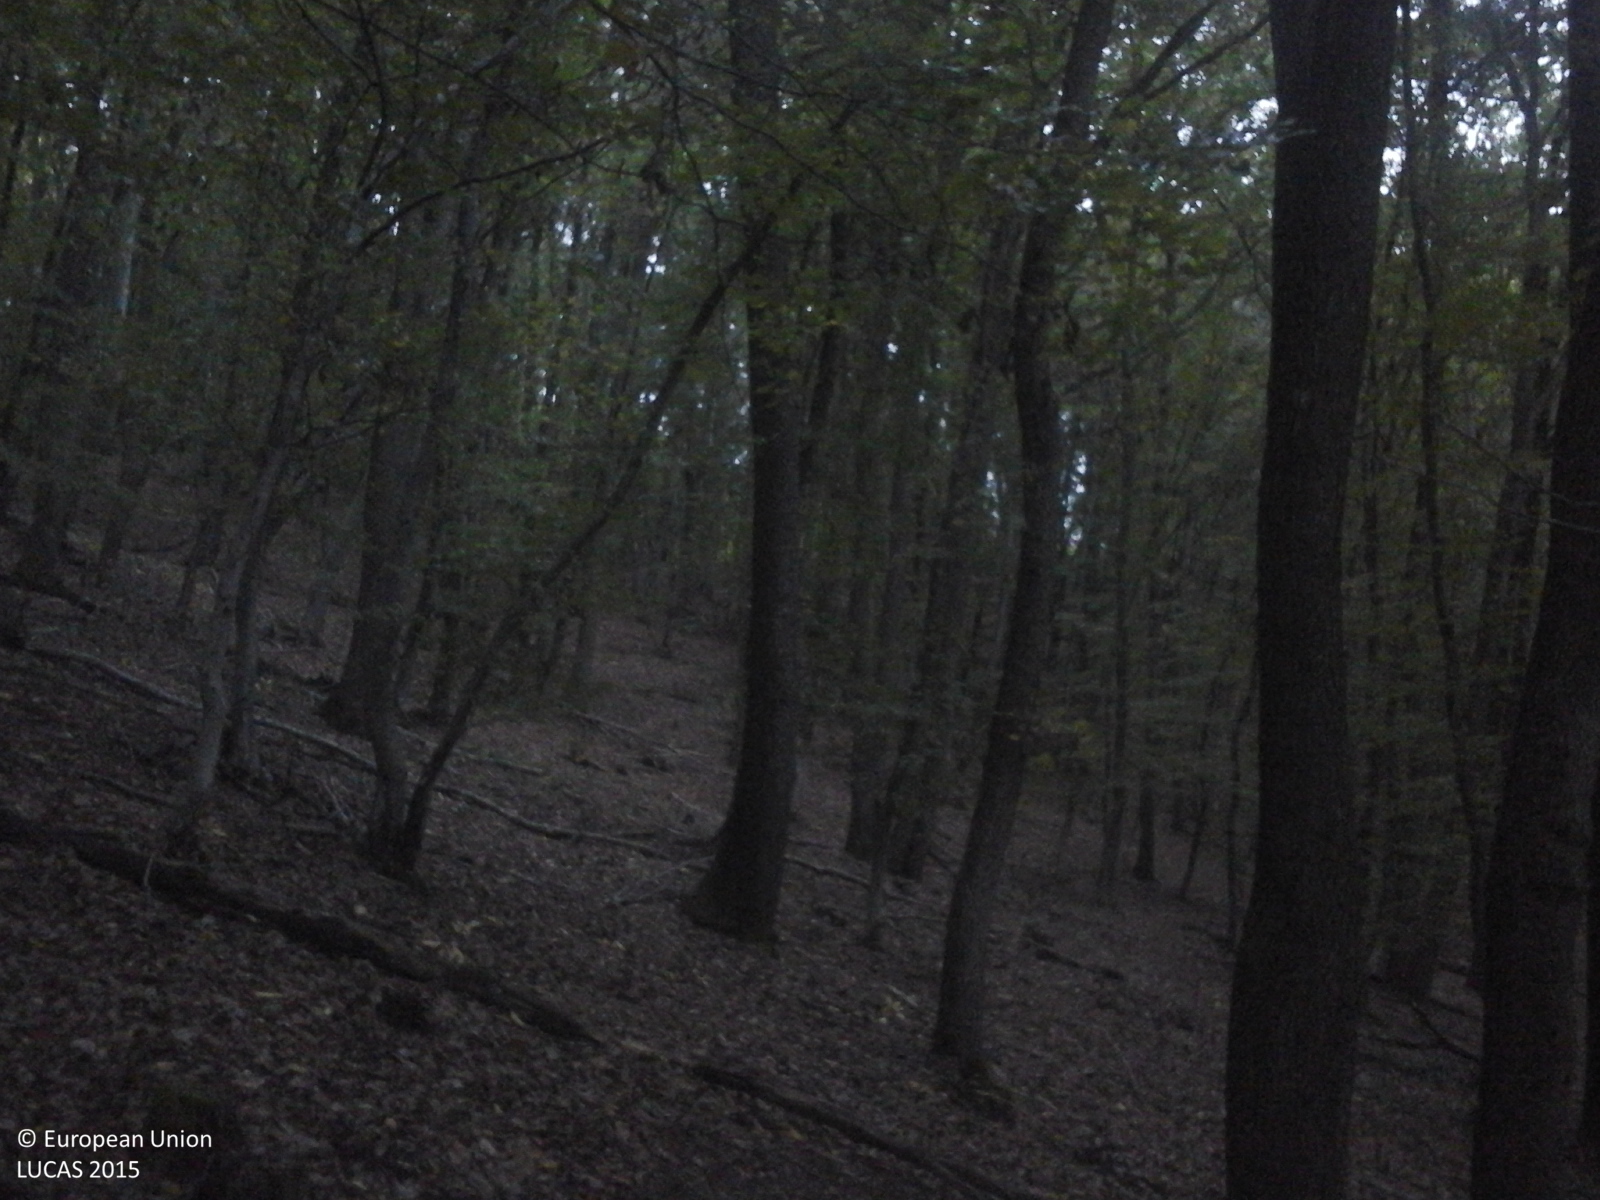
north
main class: Woodland
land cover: Broadleaved woodland
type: beech forest
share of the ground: > 75 %
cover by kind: broadleaved forest trees 100 %
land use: Forestry
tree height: > 5 m
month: October
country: RO
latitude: 46.3800
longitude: 24.7705
